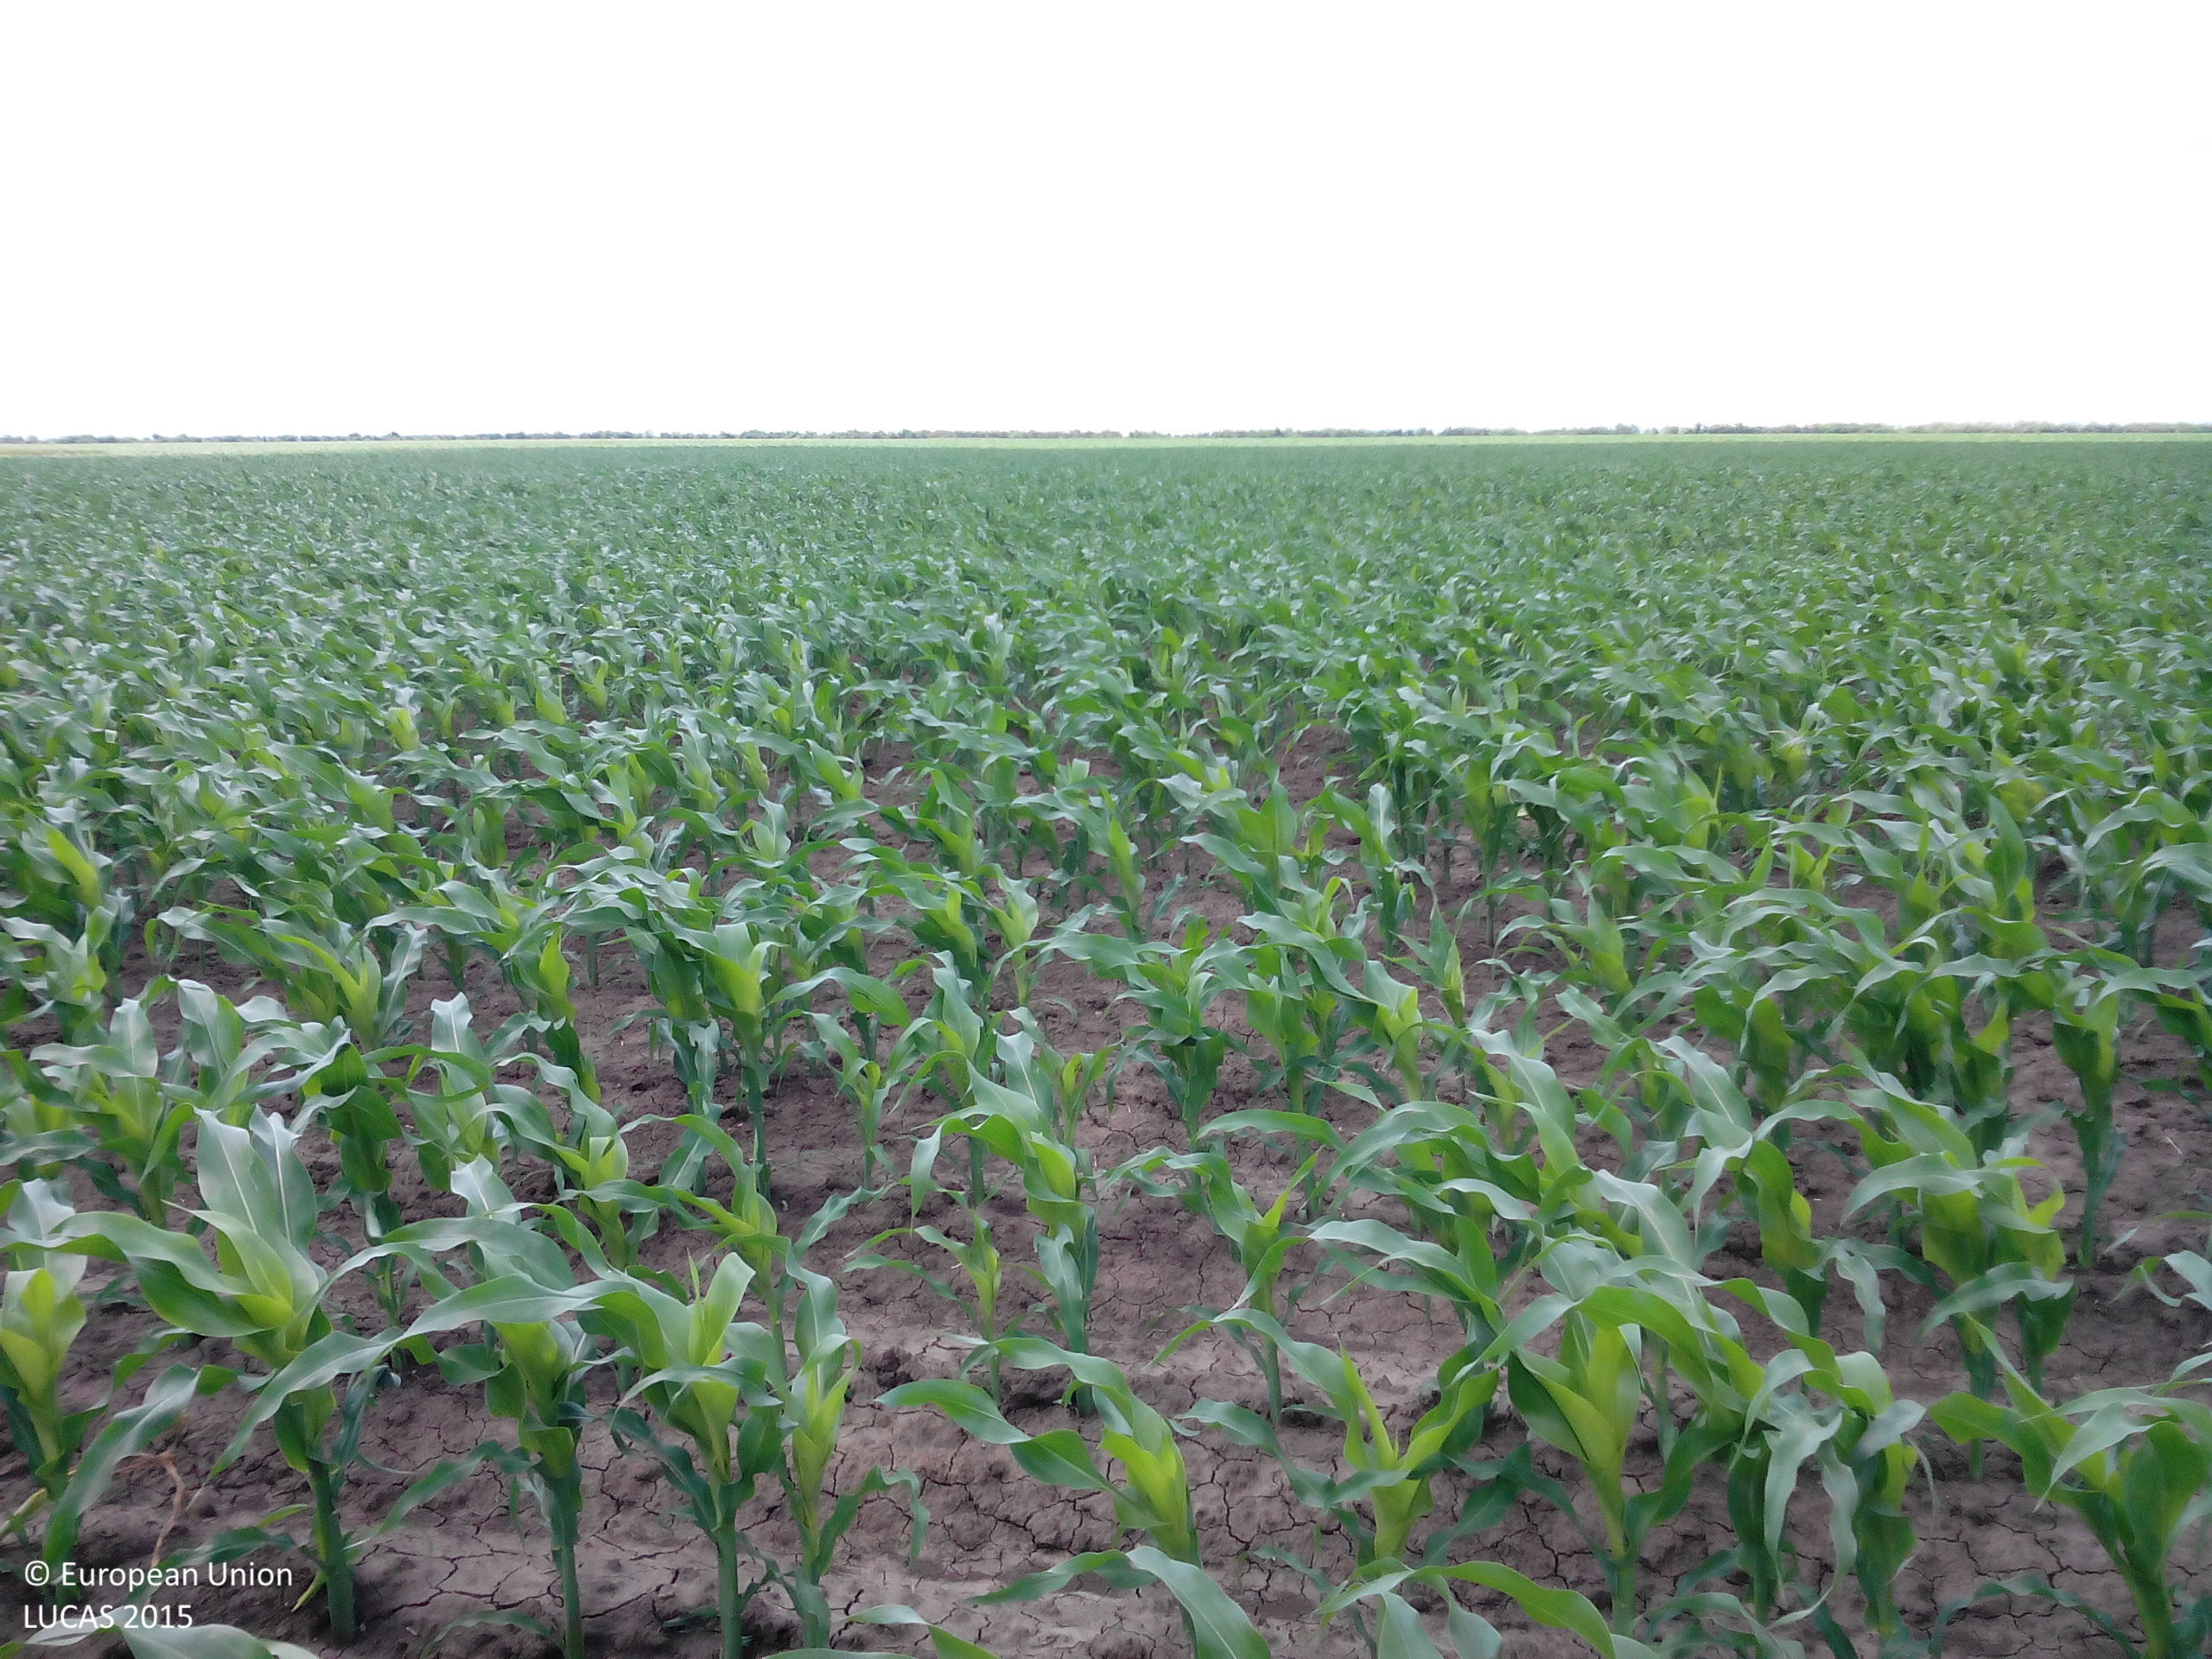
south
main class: Cropland
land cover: Maize
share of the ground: 50 - 75 %
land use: Agriculture (excluding fallow land and kitchen gardens)
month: May
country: BG
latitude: 43.4900
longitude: 24.1141
